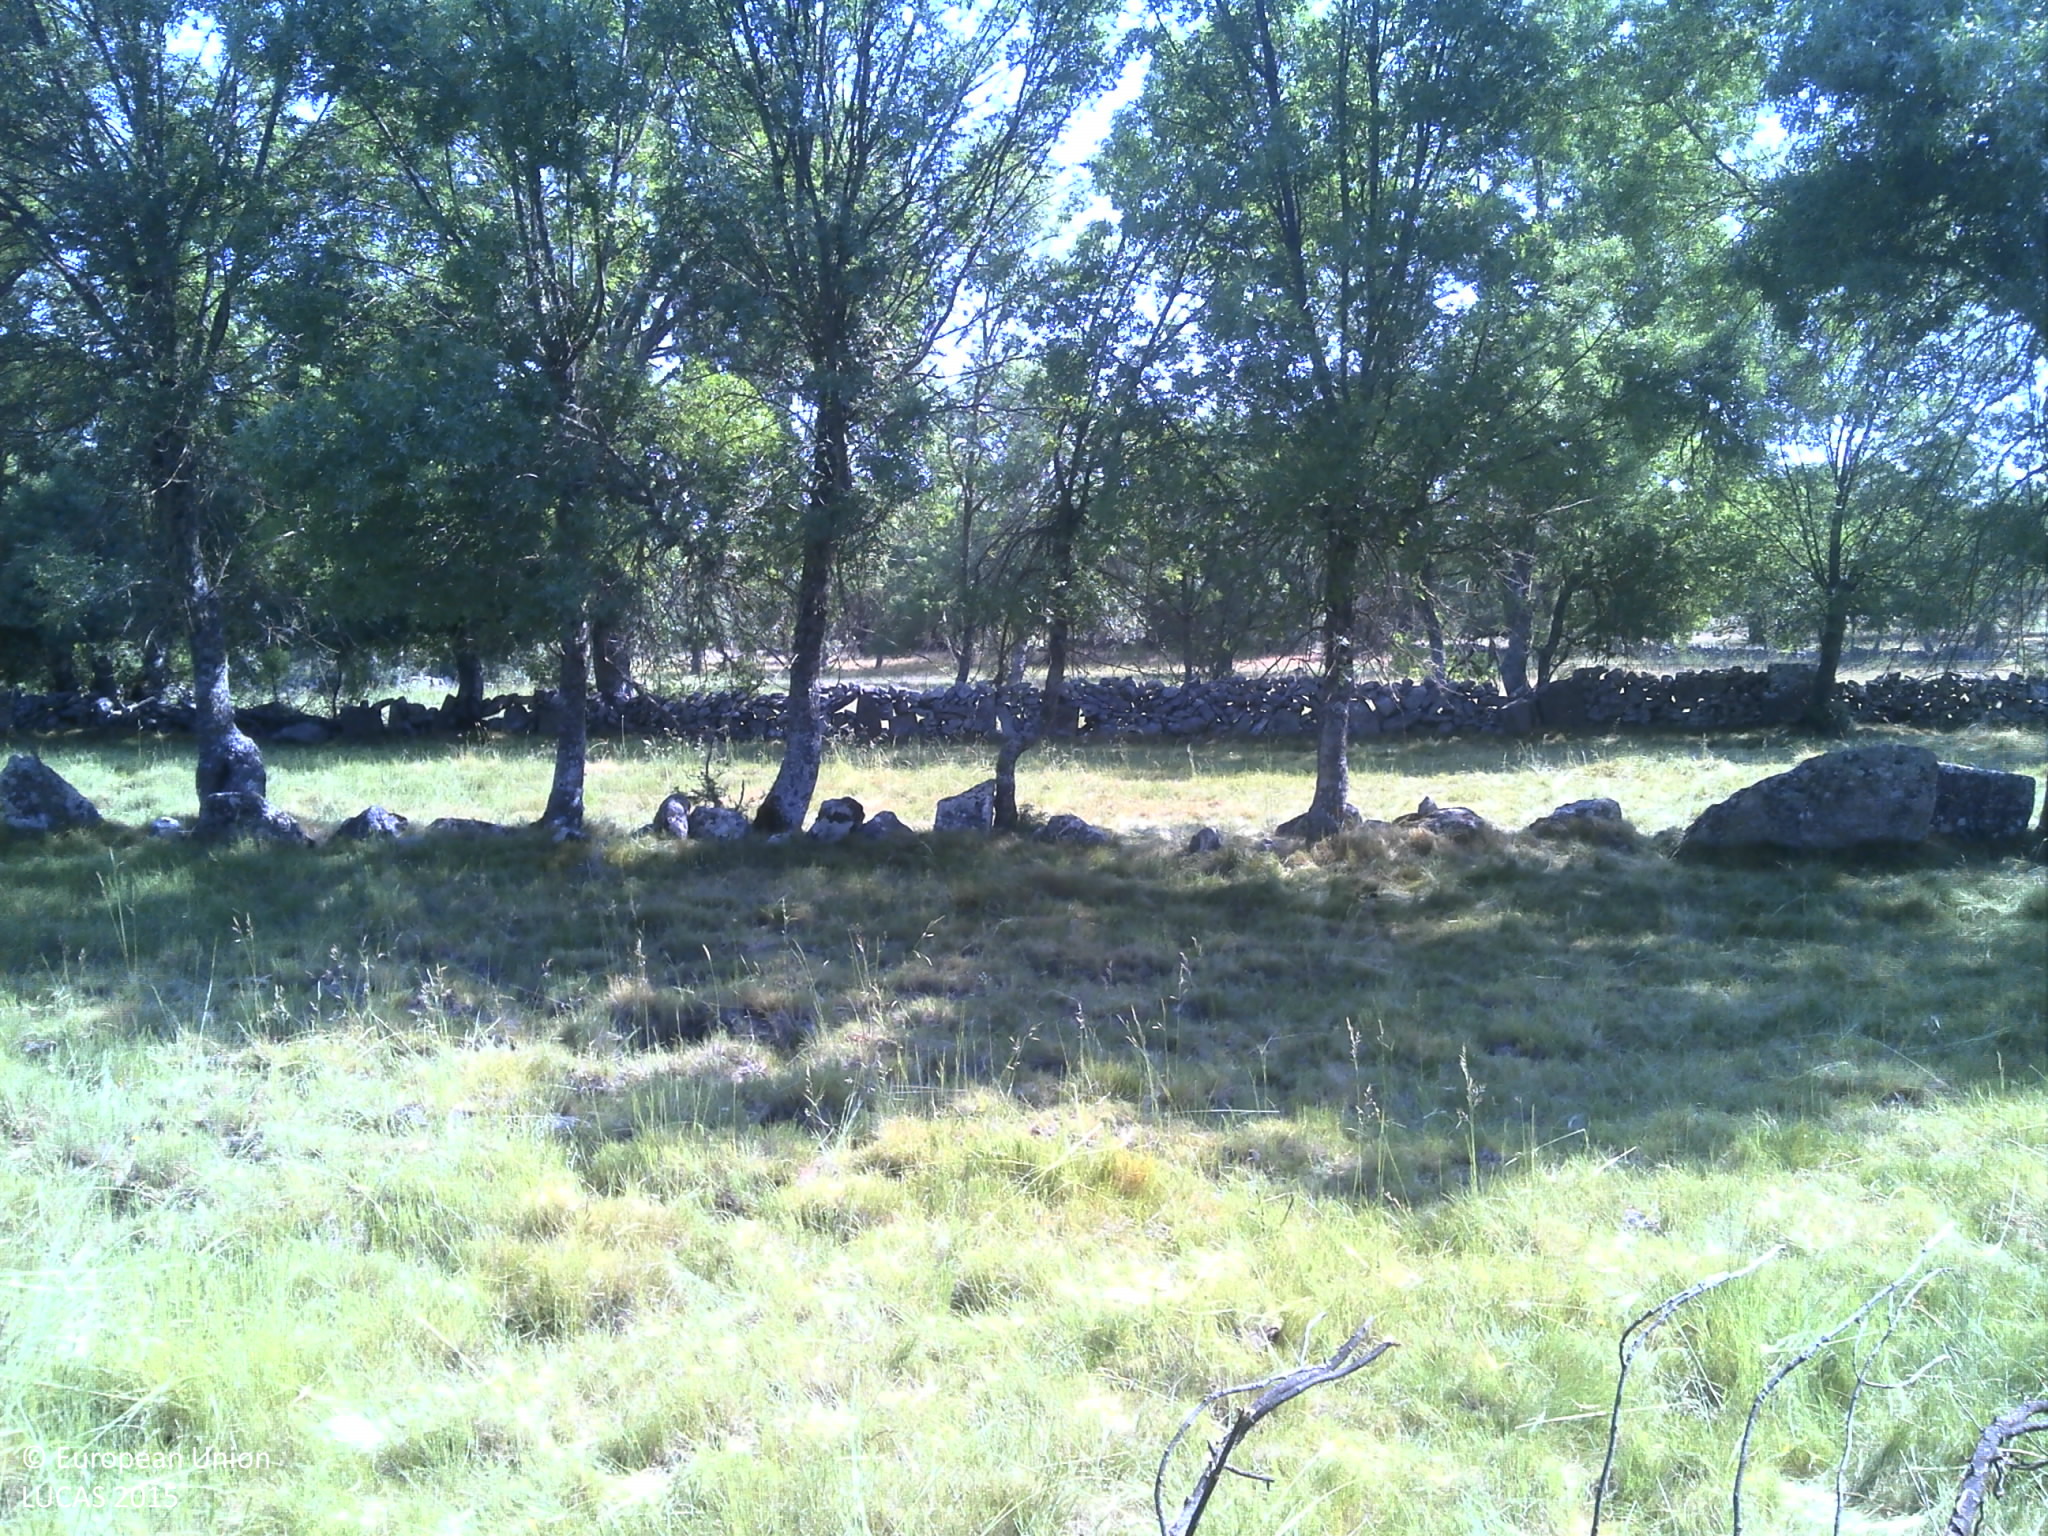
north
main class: Grassland
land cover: Grassland with sparse tree/shrub cover
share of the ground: 50 - 75 %
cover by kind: herbaceous plants 85 %, broadleaved forest trees 5 %, unconsolidated bare surface 5 %
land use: Agriculture (excluding fallow land and kitchen gardens)
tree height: > 5 m
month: June
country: PT
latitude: 40.5526
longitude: -6.8291
